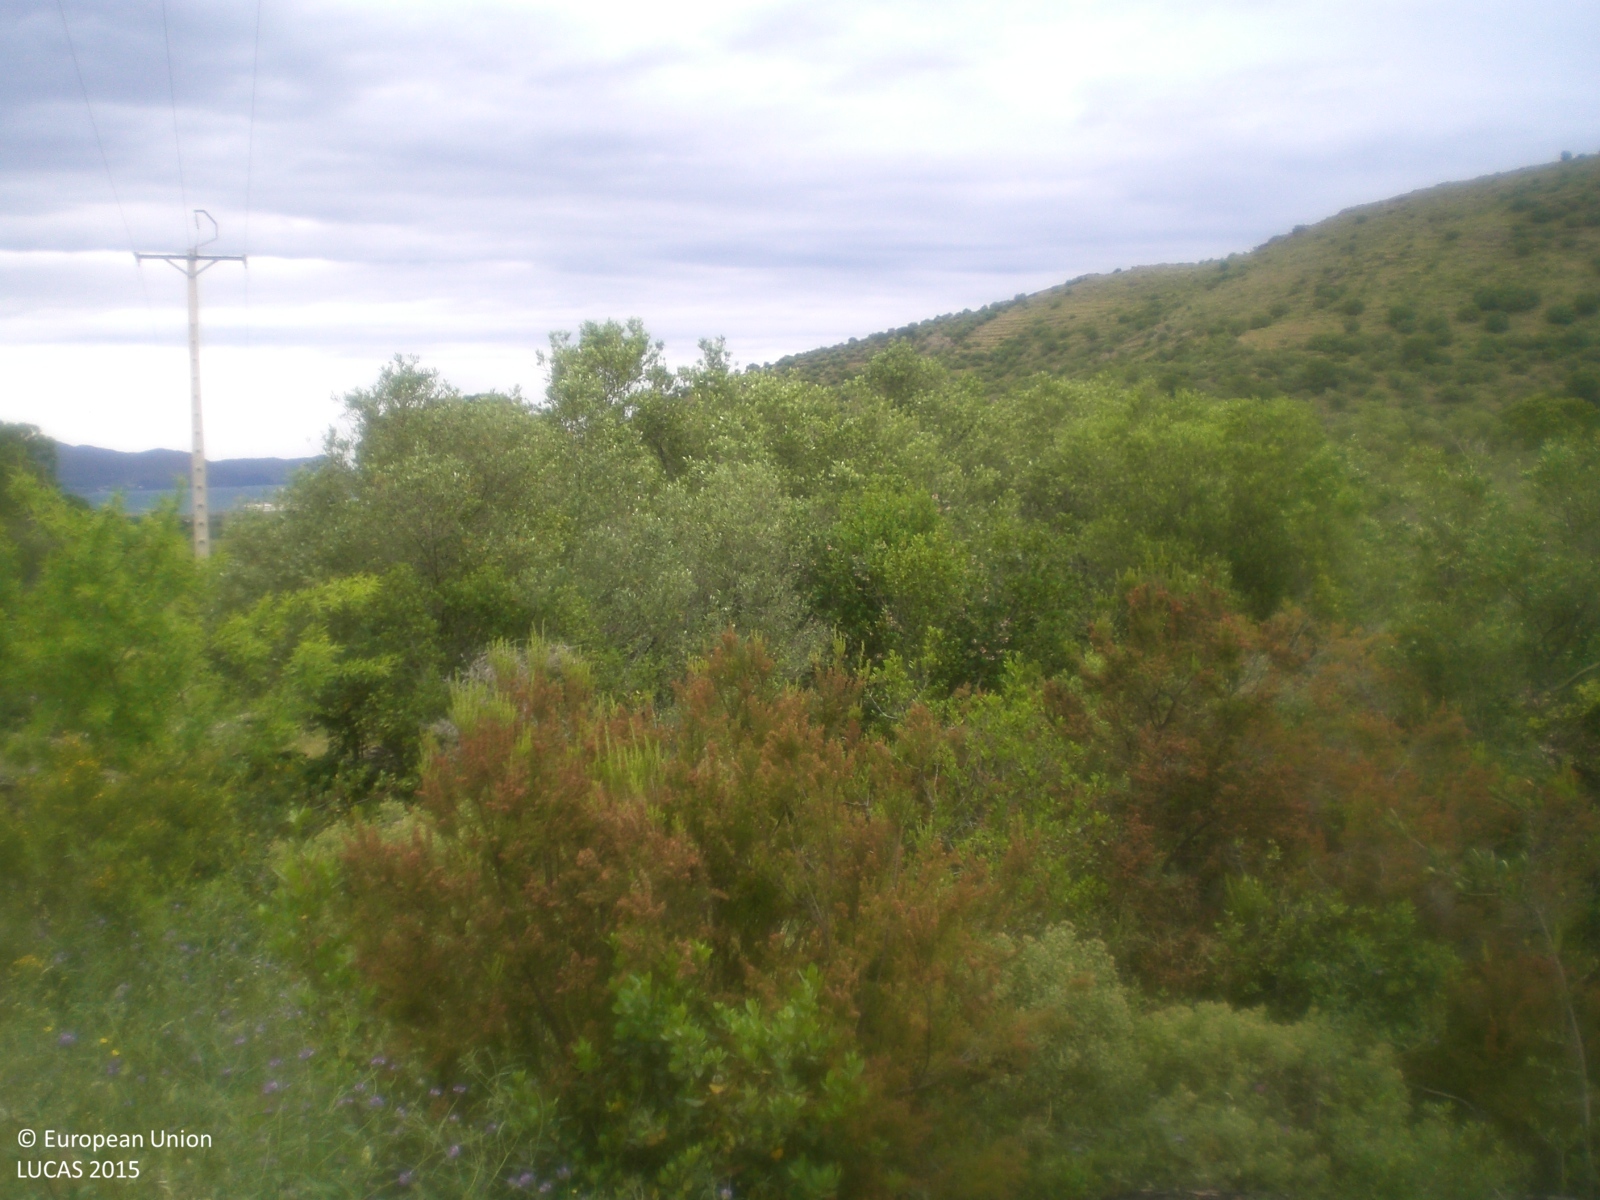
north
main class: Woodland
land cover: Pine dominated mixed woodland
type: coniferous forest of the mediterranean region
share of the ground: 10 - 25 %
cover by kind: herbaceous plants 30 %, coniferous forest trees 25 %, shrubs 25 %, broadleaved forest trees 10 %, consolidated bare surface 10 %
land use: Forestry
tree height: > 5 m
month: May
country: ES
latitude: 42.3171
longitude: 3.2075
